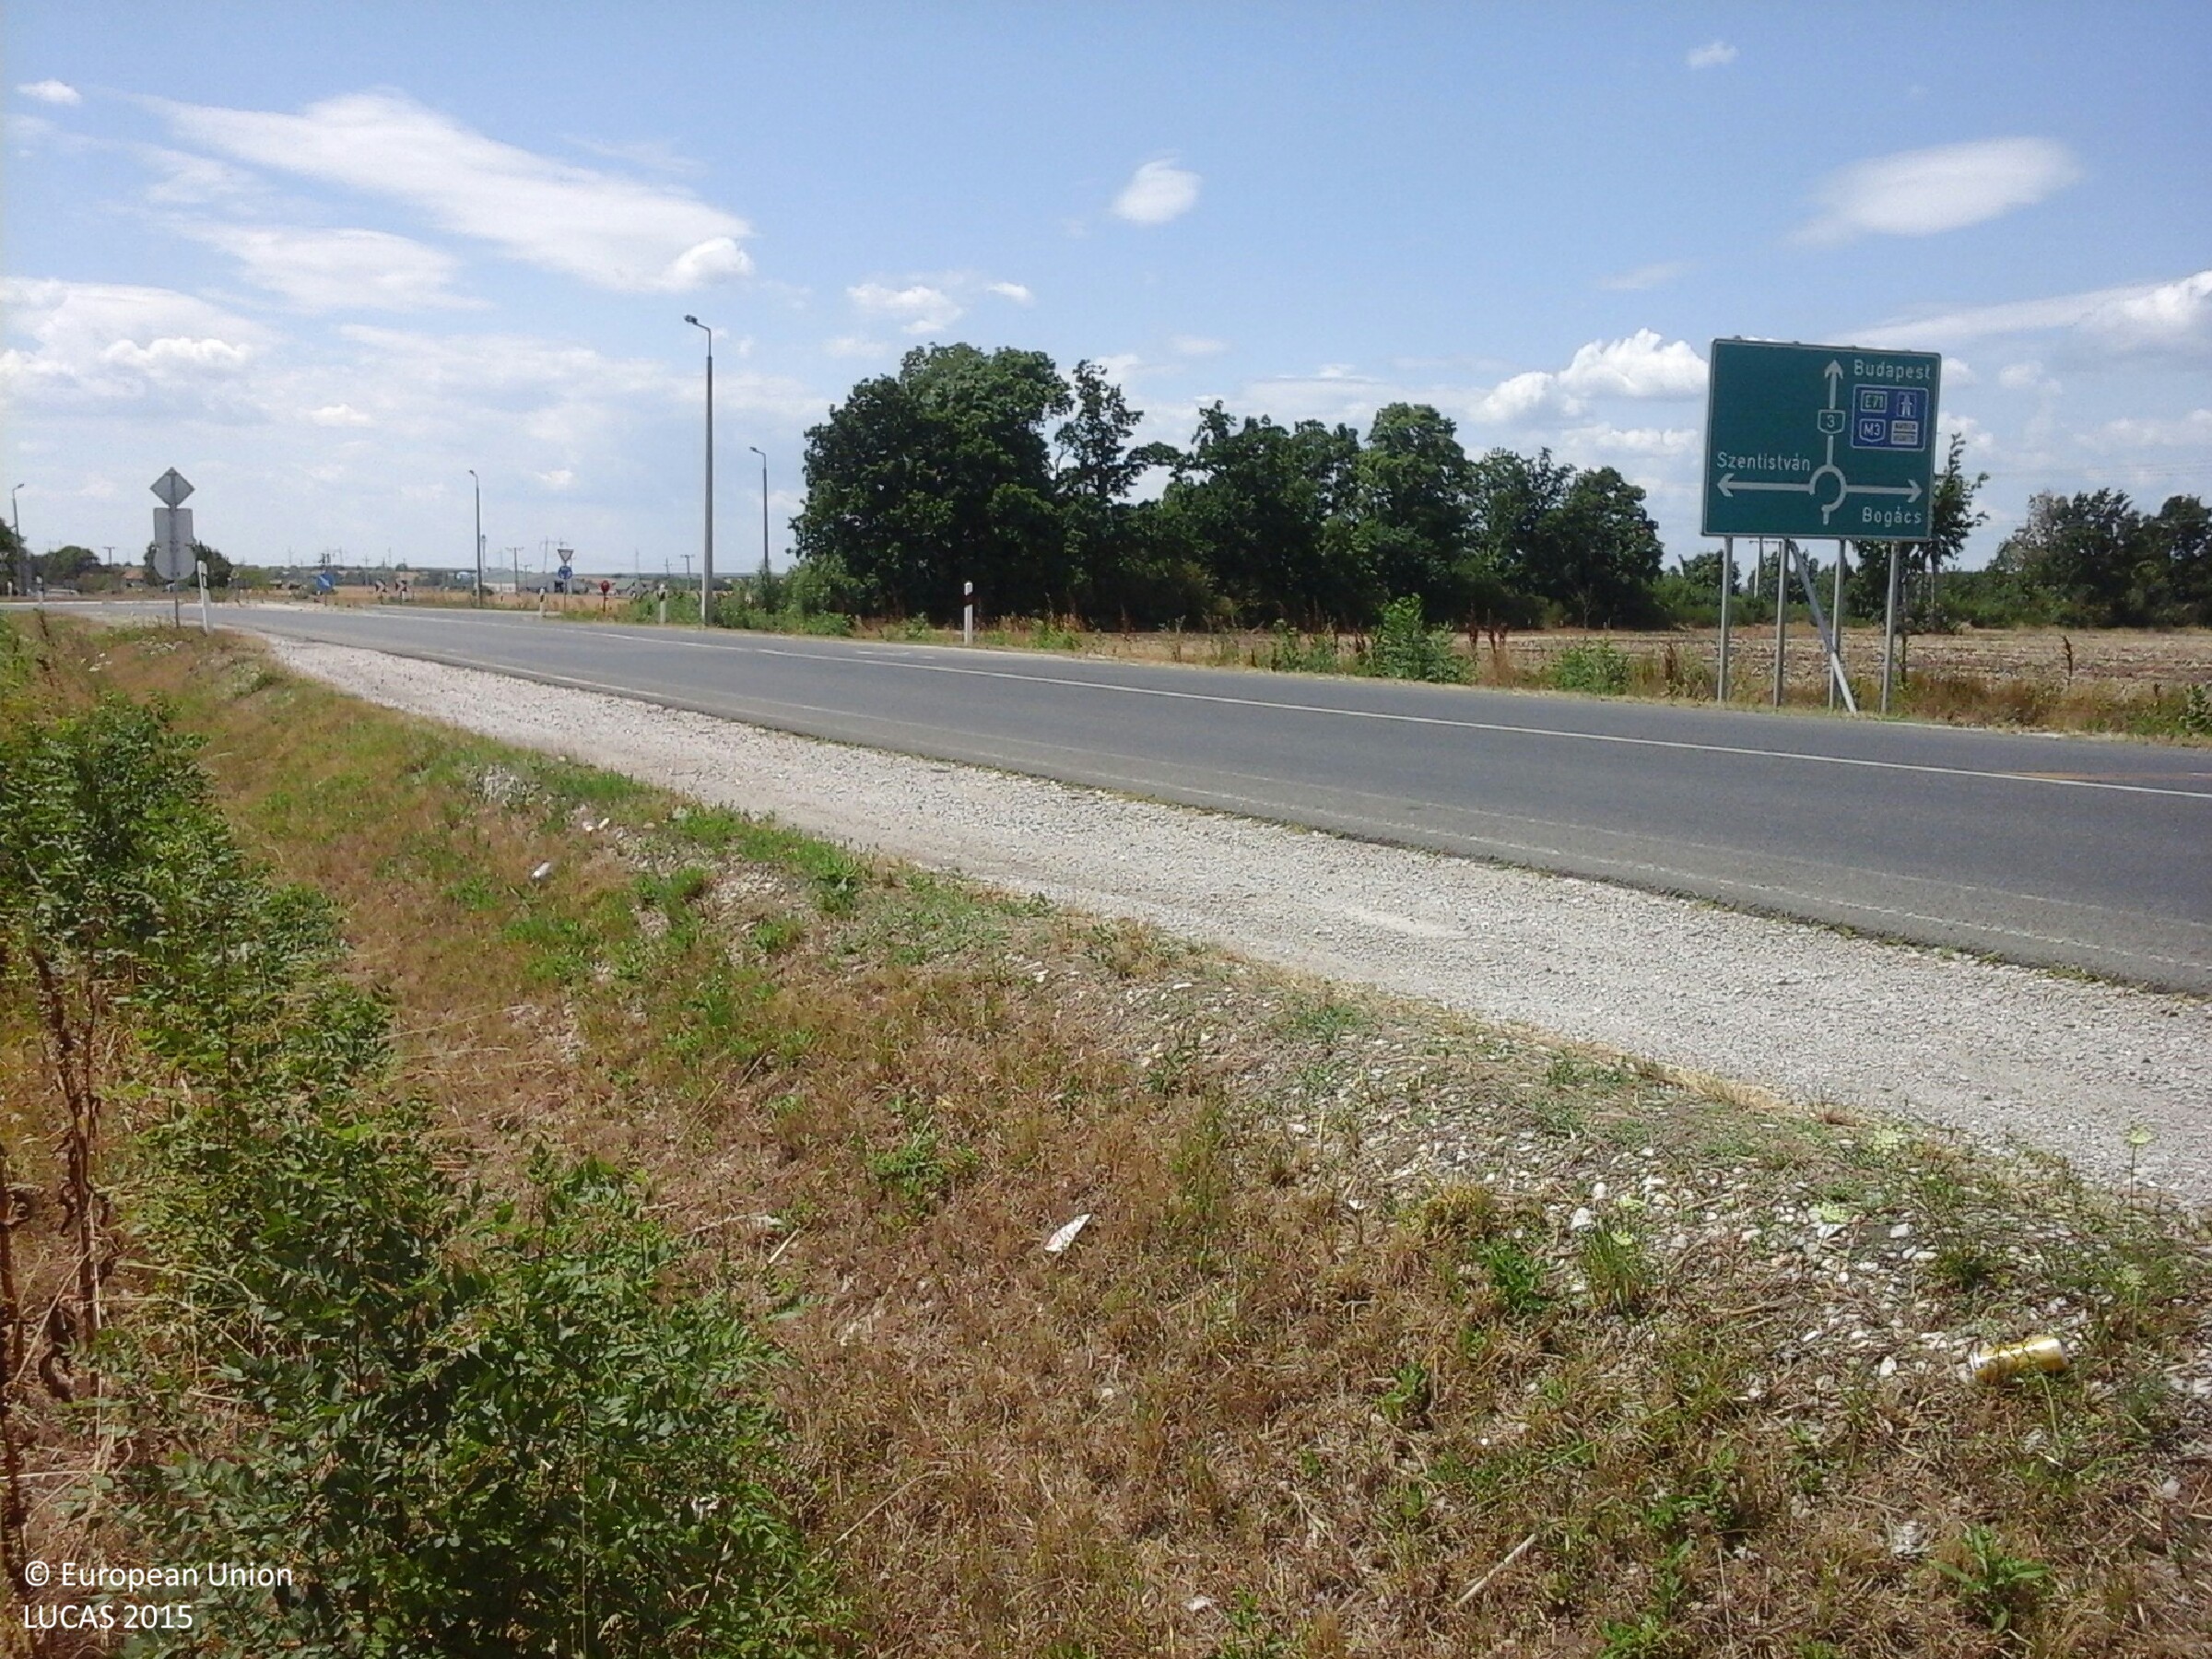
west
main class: Cropland
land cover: Dry pulses
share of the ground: > 75 %
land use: Agriculture (excluding fallow land and kitchen gardens)
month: July
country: HU
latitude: 47.8226
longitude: 20.5719
